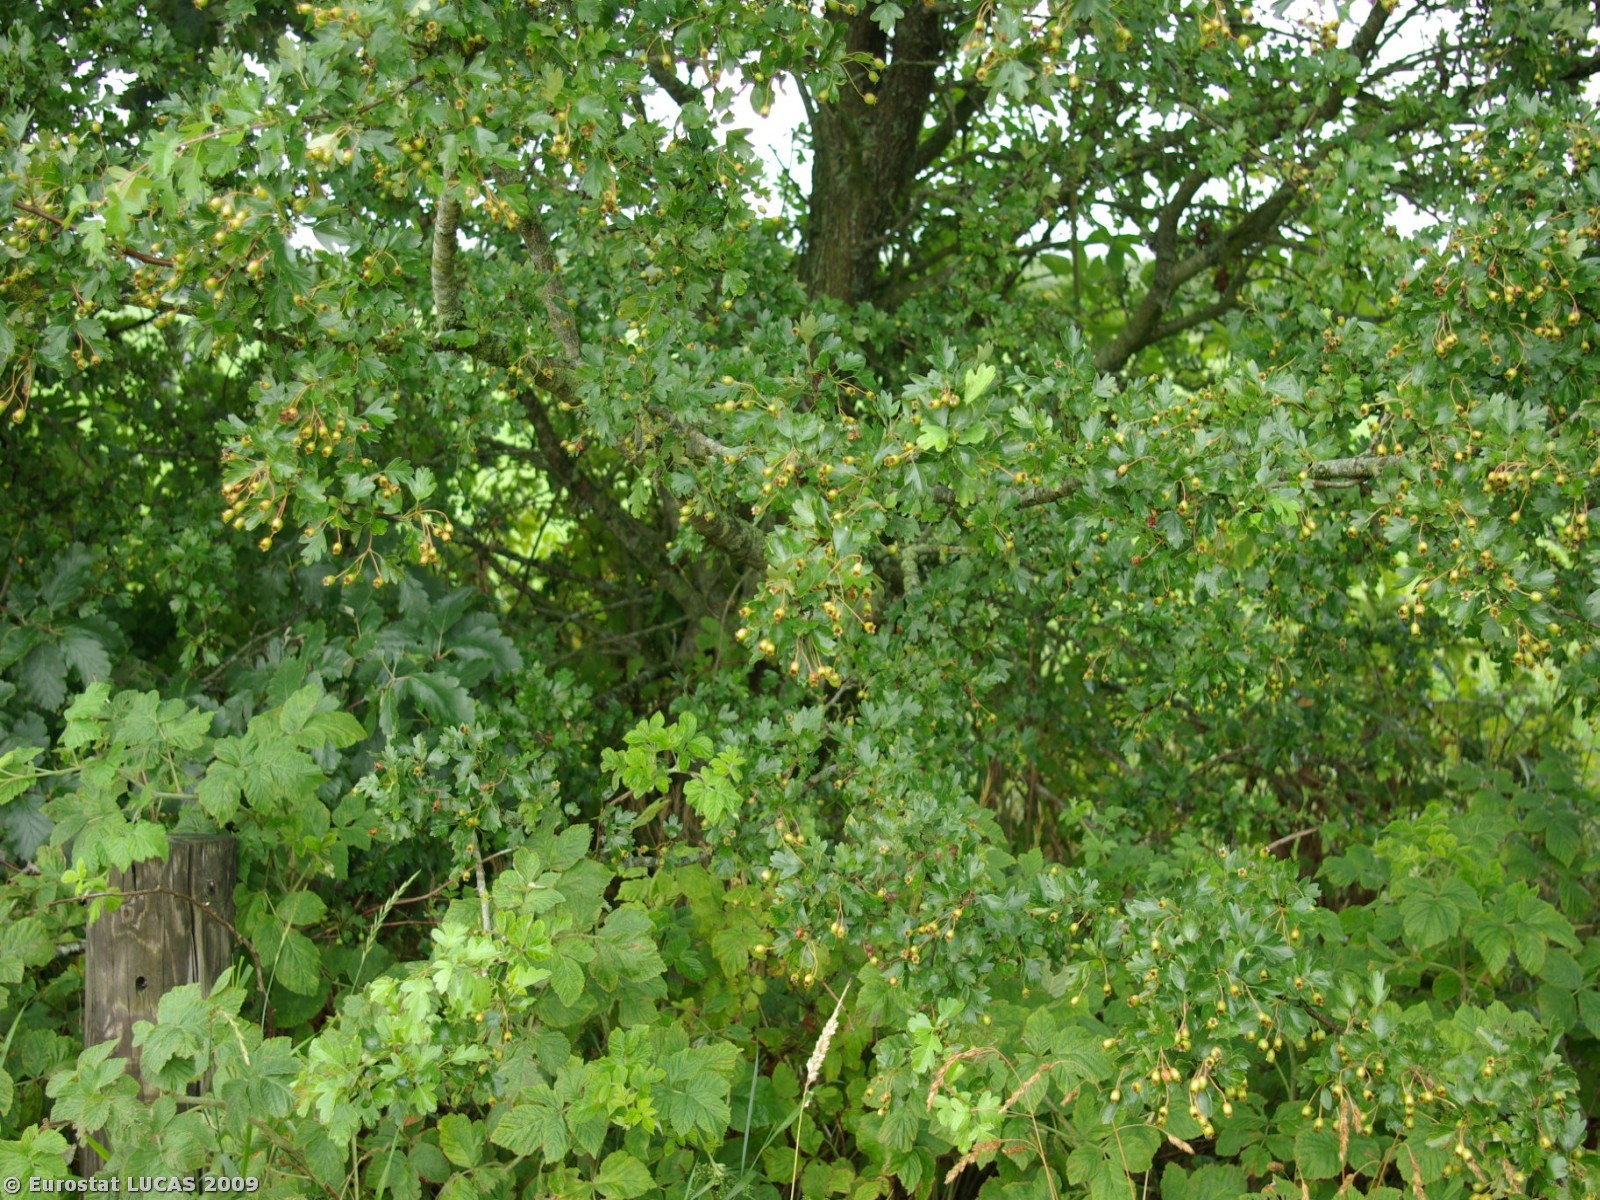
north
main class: Cropland
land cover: Barley
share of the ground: > 75 %
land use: Agriculture (excluding fallow land and kitchen gardens)
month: July
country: DK
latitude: 55.2658
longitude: 8.8521
